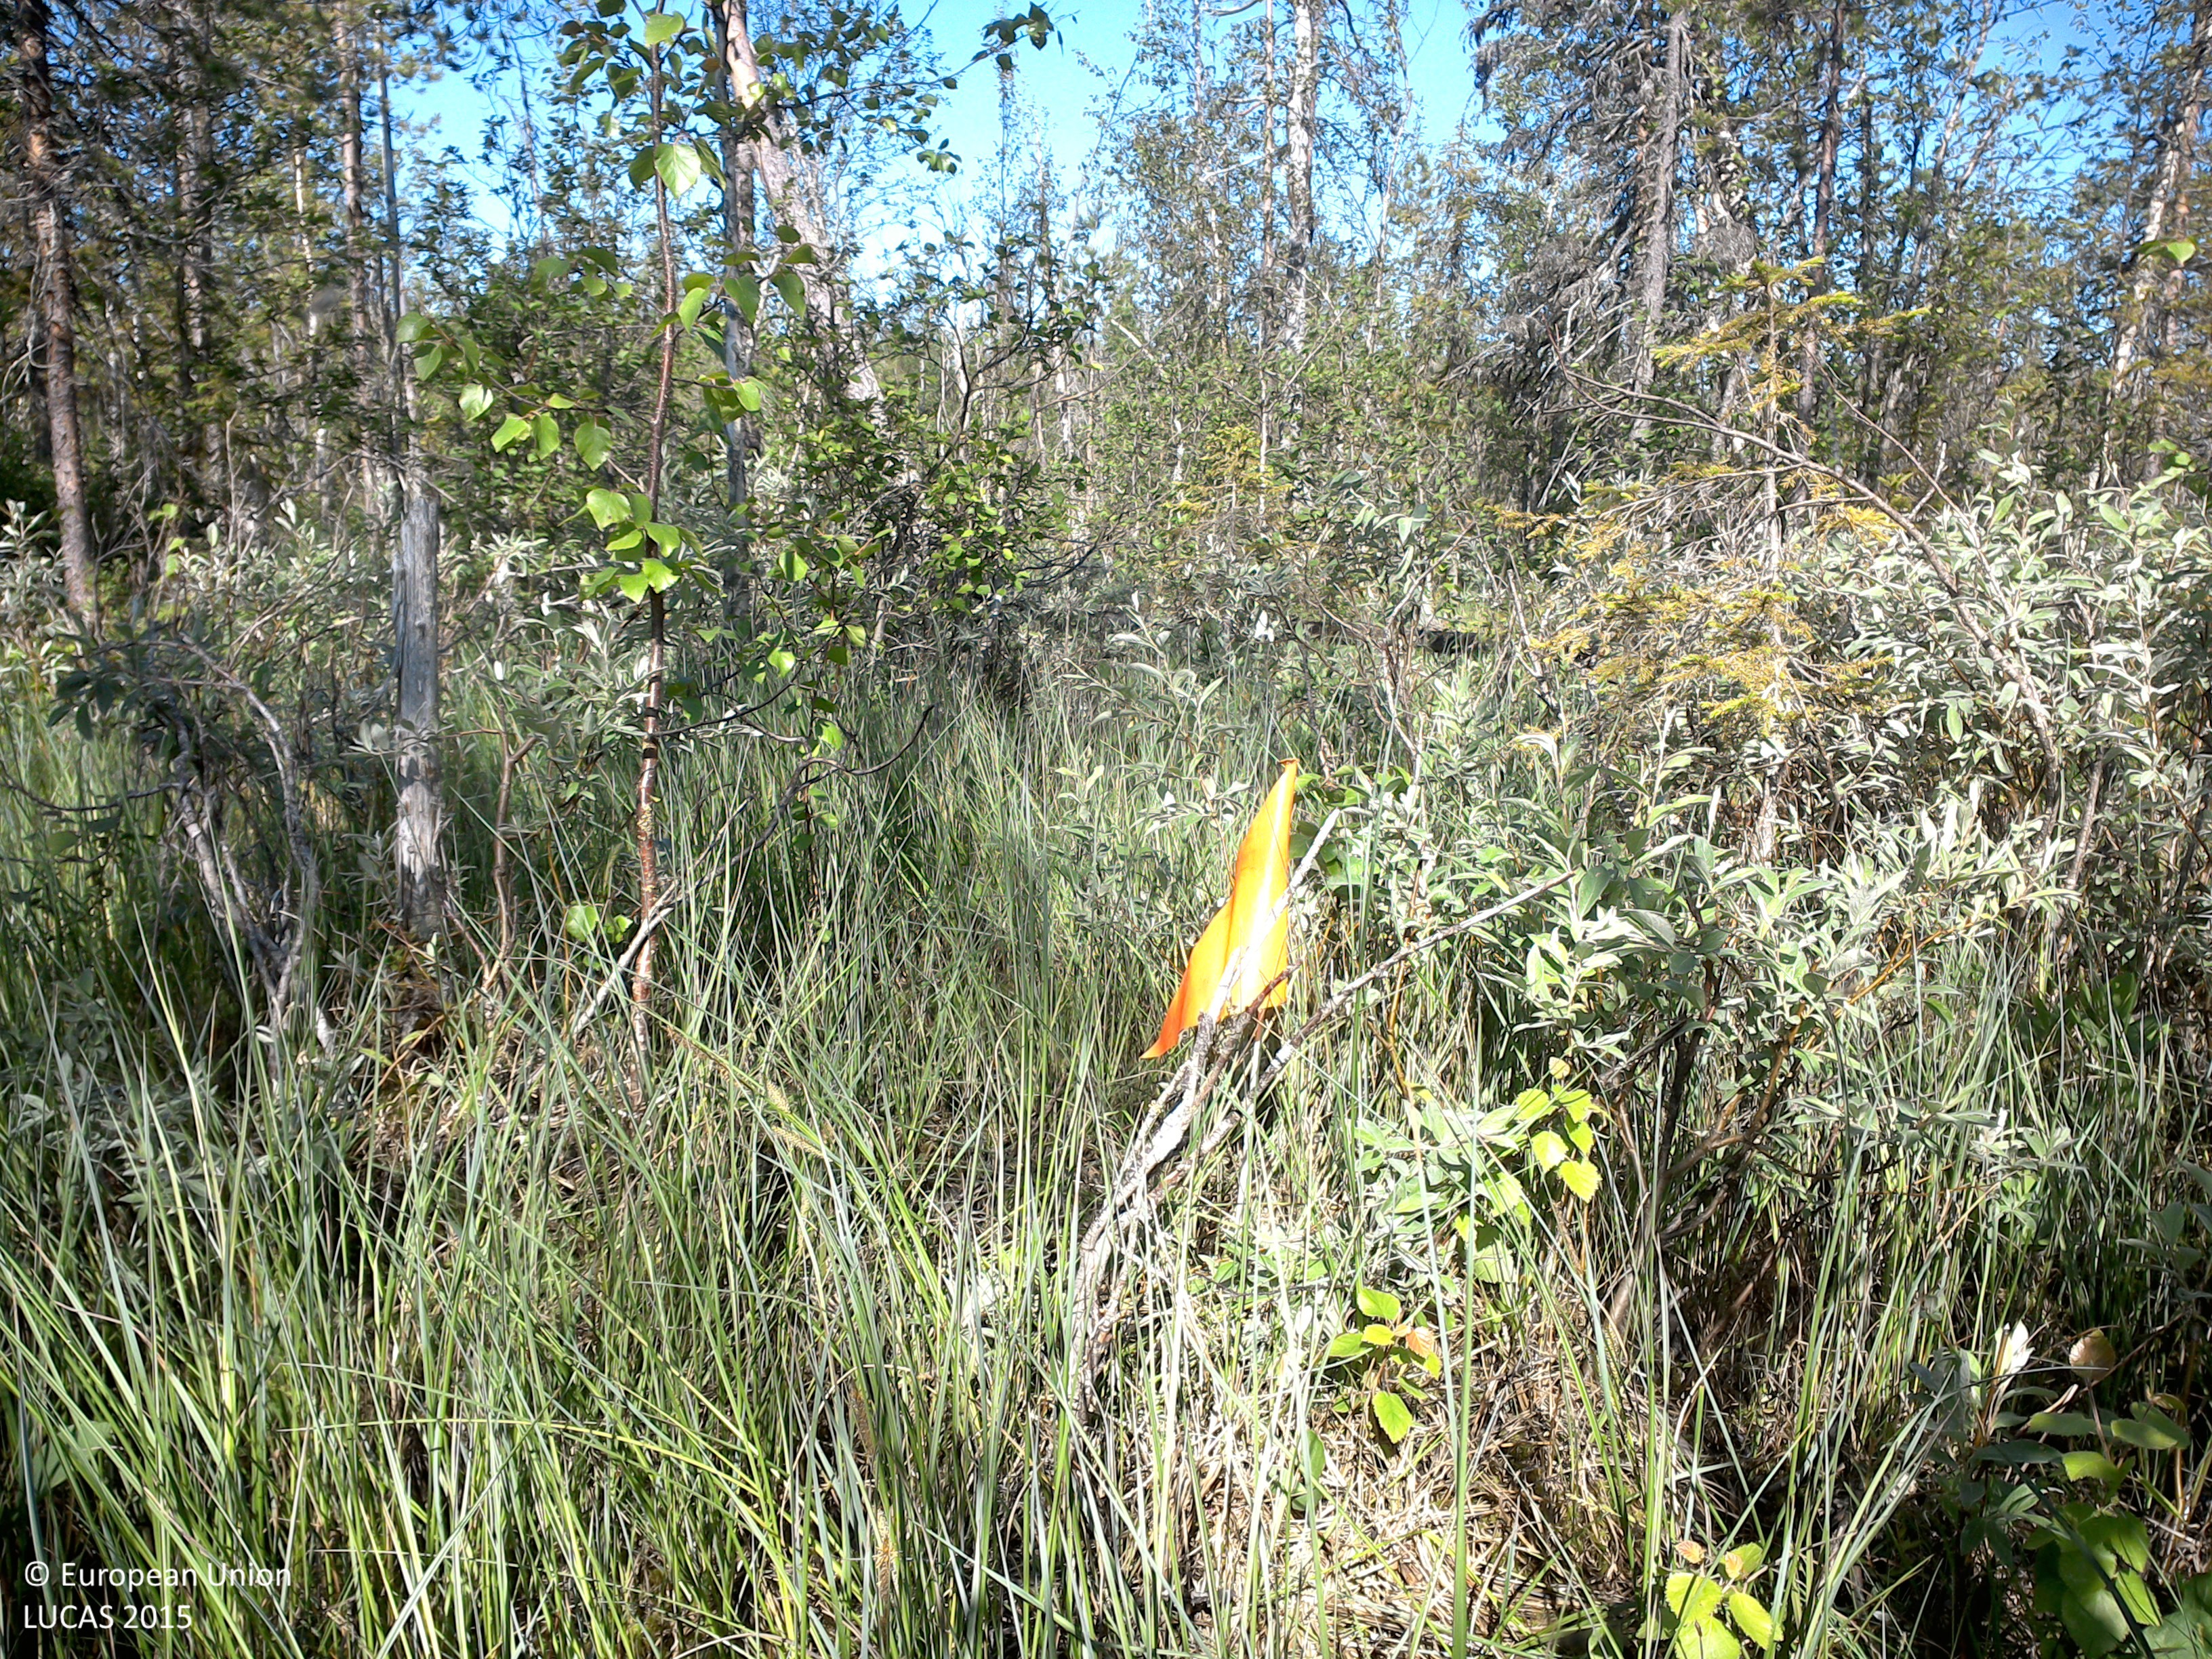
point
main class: Woodland
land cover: Pine dominated mixed woodland
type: boreal forest
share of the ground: 10 - 25 %
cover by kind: herbaceous plants 55 %, shrubs 20 %, coniferous forest trees 10 %, lichens and mosses 10 %, broadleaved forest trees 5 %
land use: Forestry
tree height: > 5 m
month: July
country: SE
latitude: 66.8200
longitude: 23.7105
